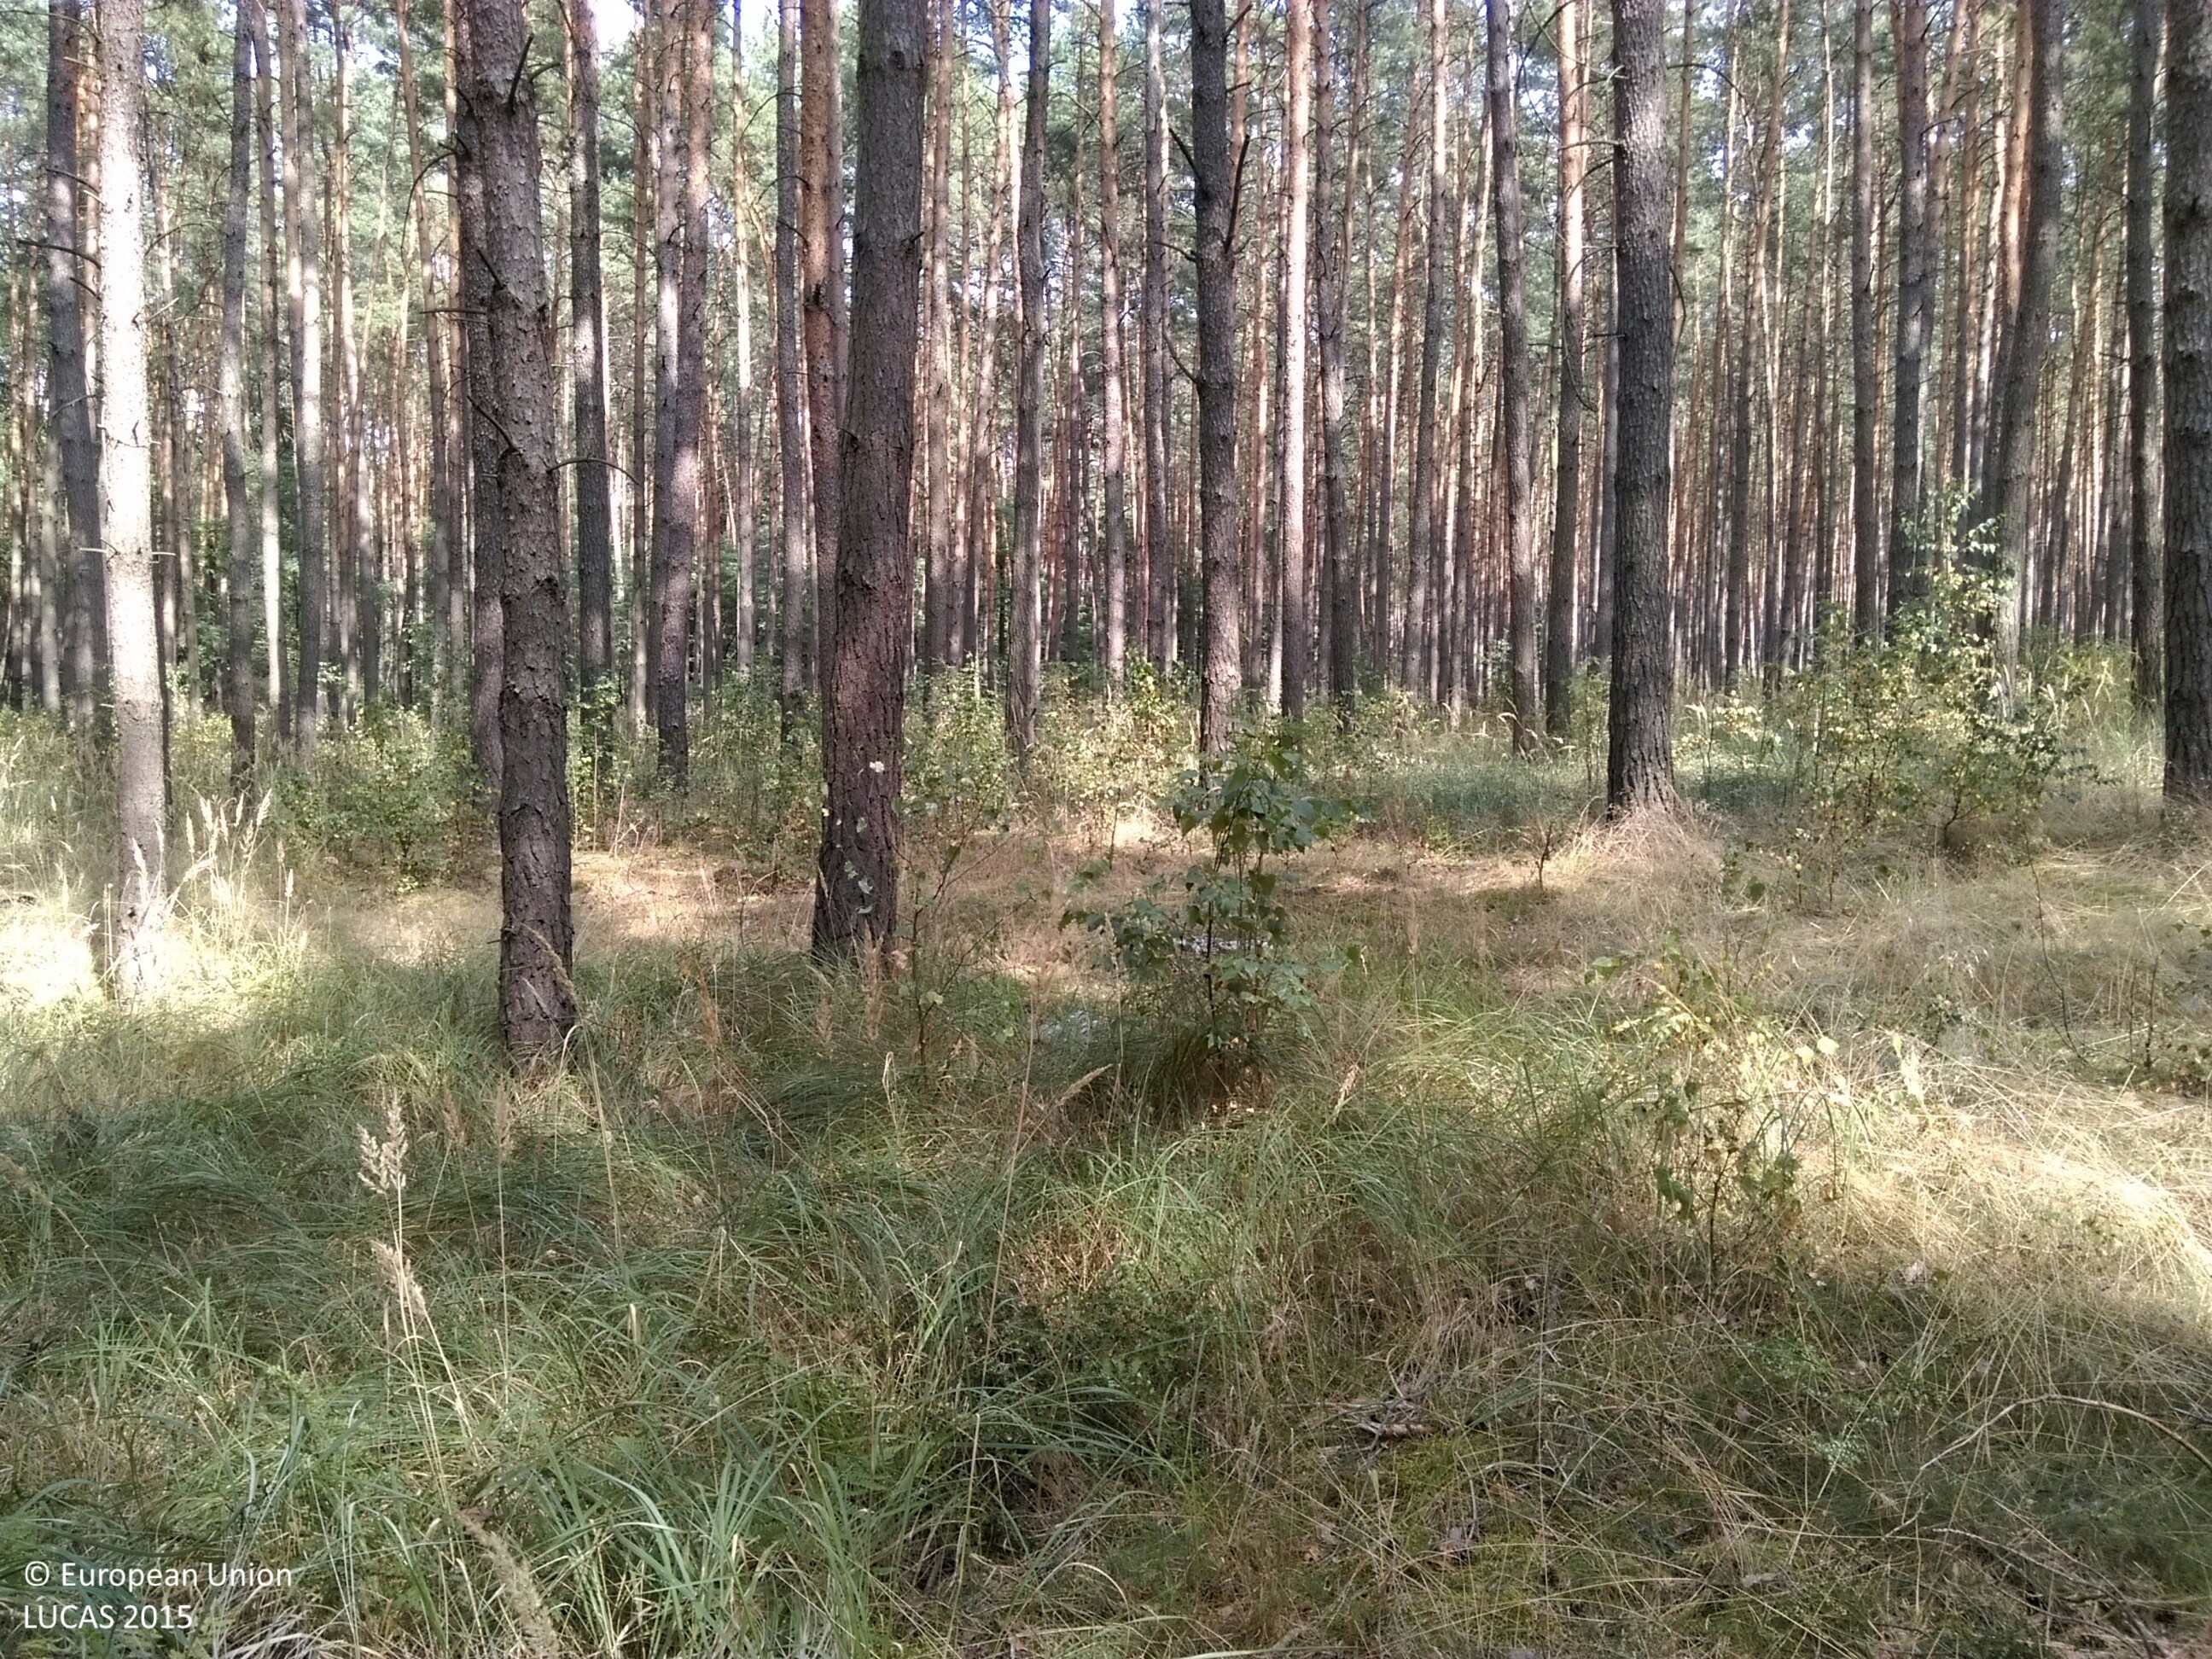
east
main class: Woodland
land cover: Pine dominated coniferous woodland
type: hemiboreal forest and nemoral coniferous forest and mixed broadleaved-coniferous forest
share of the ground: > 75 %
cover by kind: coniferous forest trees 80 %, lichens and mosses 20 %
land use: Forestry
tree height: > 5 m
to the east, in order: Pine dominated coniferous woodland; Tracks; Pine dominated coniferous woodland; Tracks; Pine dominated coniferous woodland
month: August
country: PL
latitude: 52.2089
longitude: 15.6092
